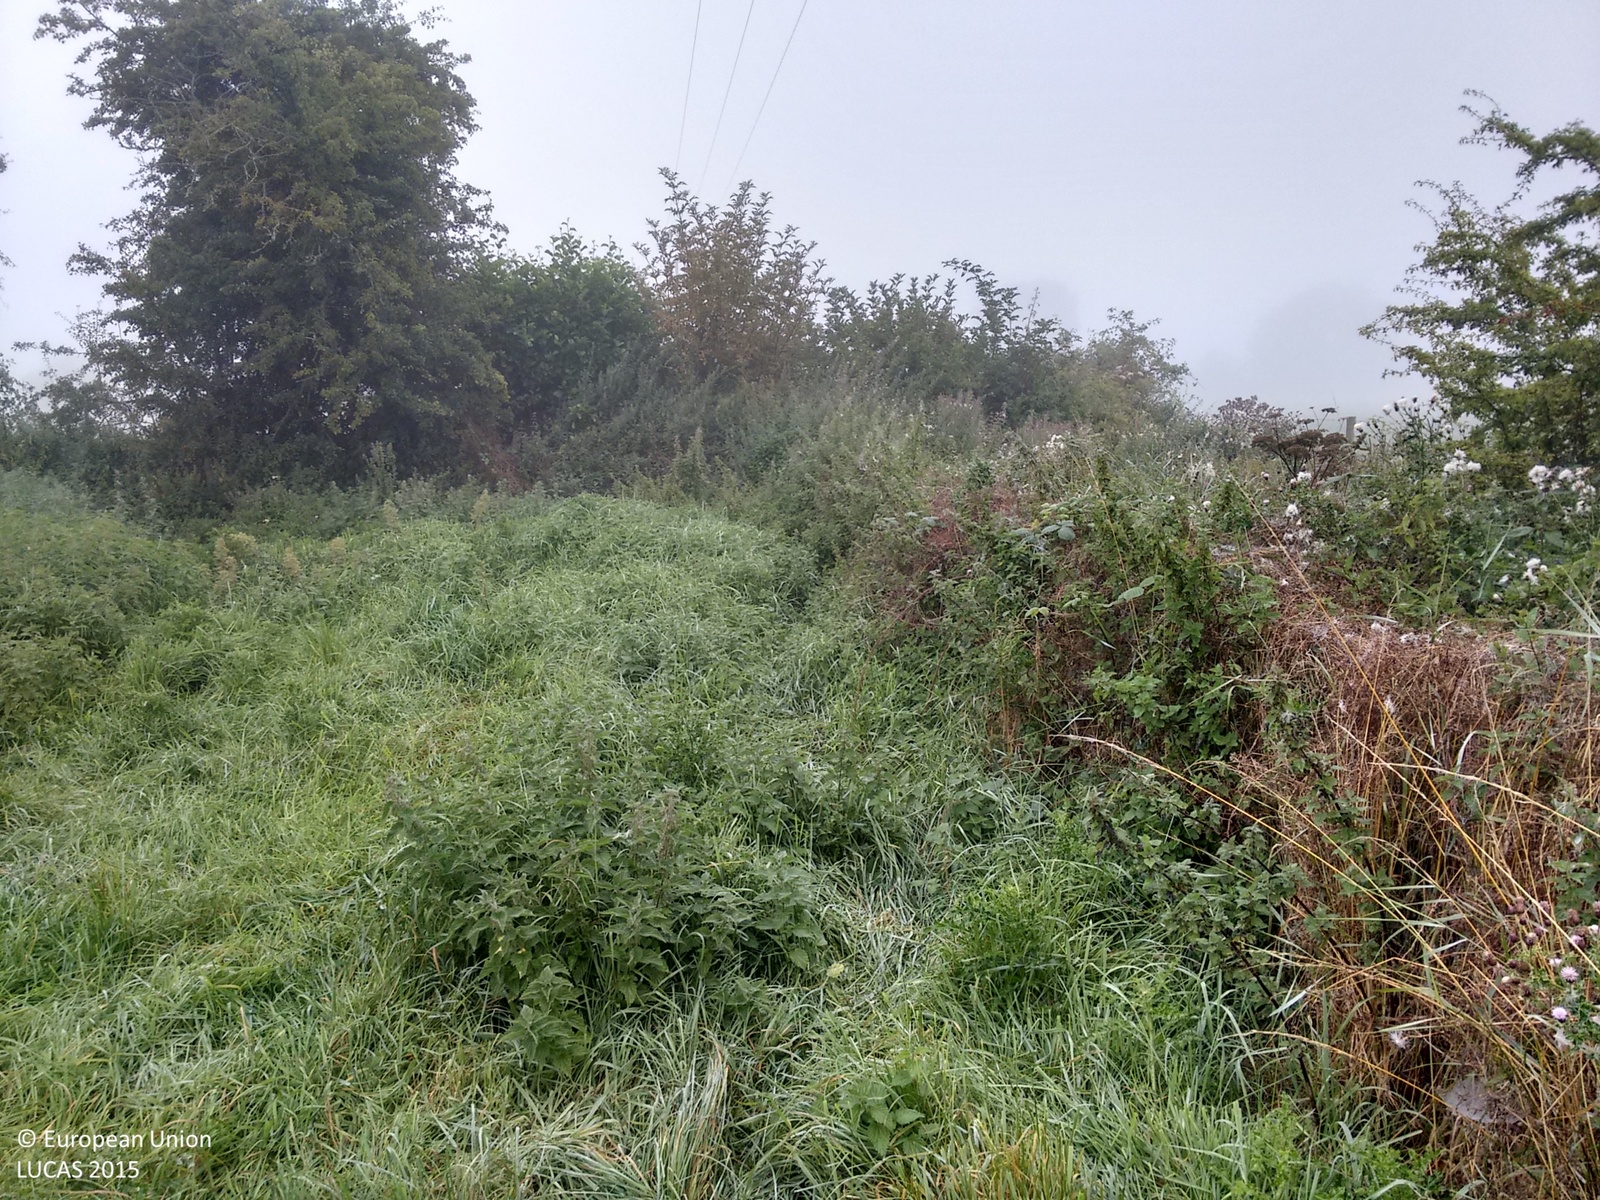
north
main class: Grassland
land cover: Grassland without tree/shrub cover
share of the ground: > 75 %
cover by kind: herbaceous plants 100 %
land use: Agriculture (excluding fallow land and kitchen gardens)
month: September
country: GB
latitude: 52.8199
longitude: -2.8785
